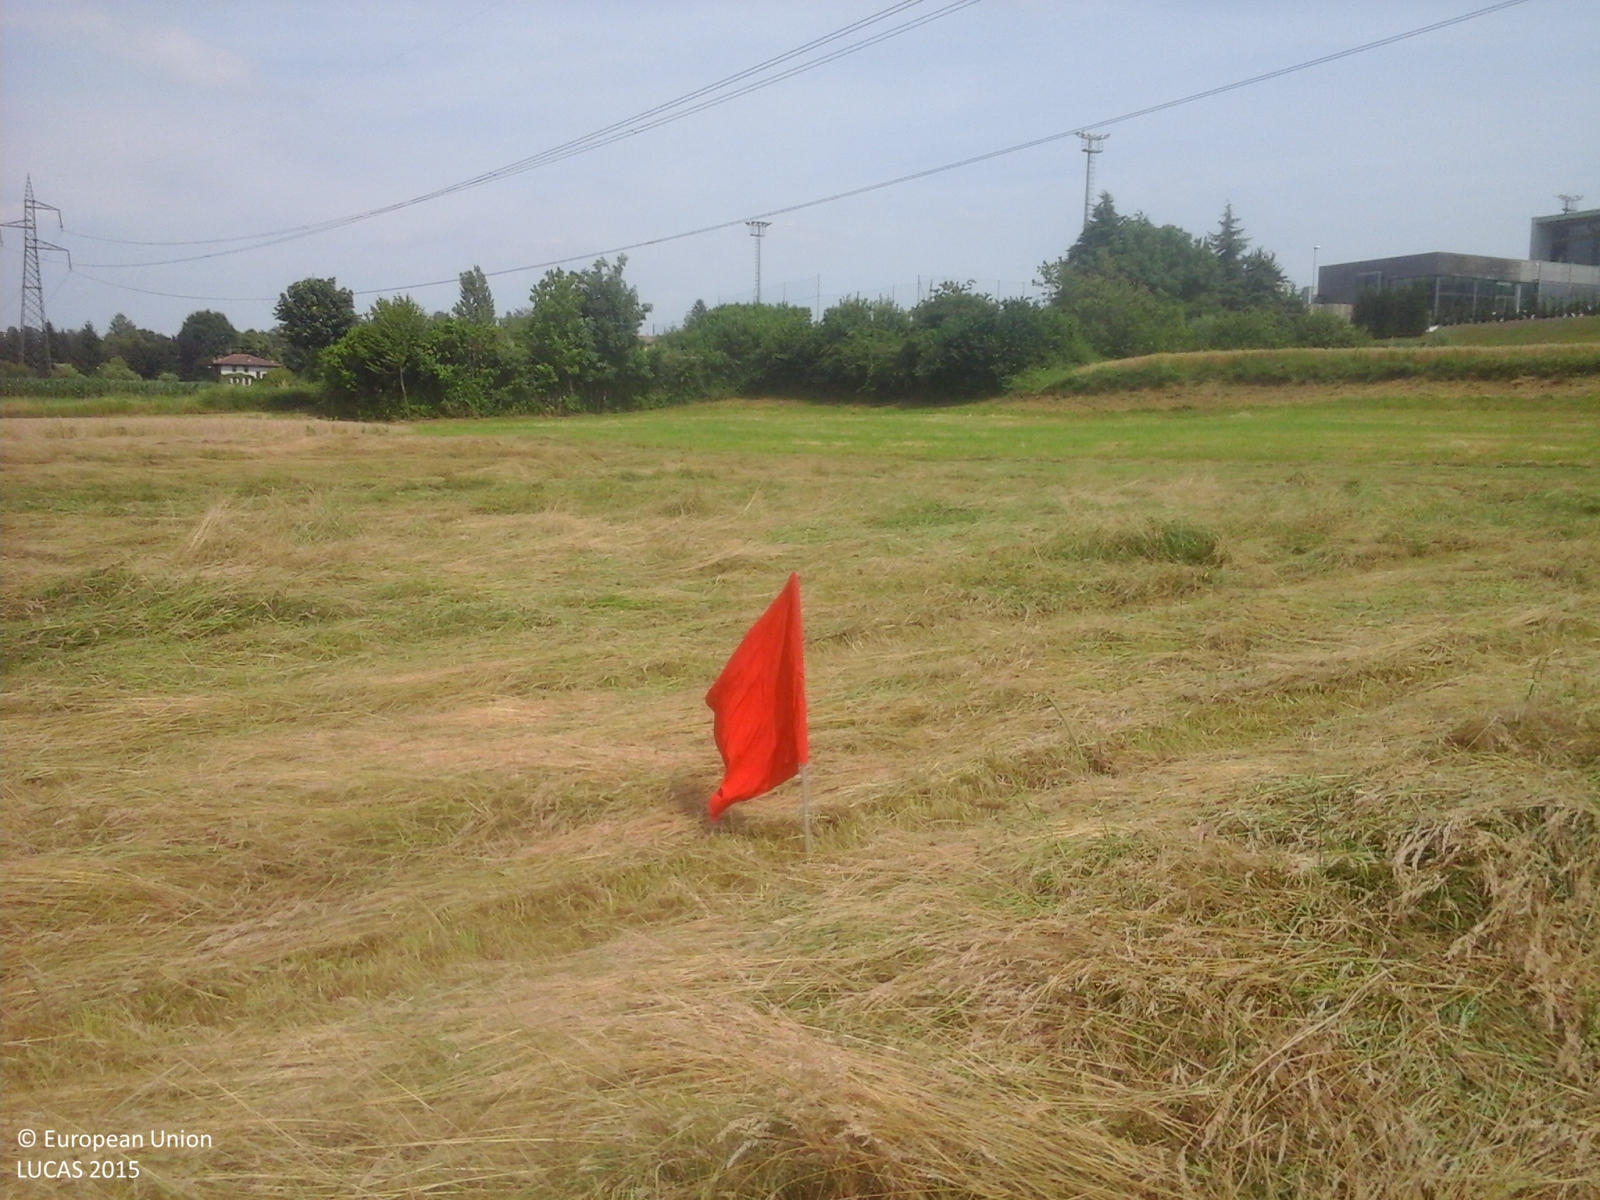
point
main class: Grassland
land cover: Grassland without tree/shrub cover
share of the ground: > 75 %
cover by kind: herbaceous plants 100 %
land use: Agriculture (excluding fallow land and kitchen gardens)
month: June
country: IT
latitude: 45.7183
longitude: 9.2945
